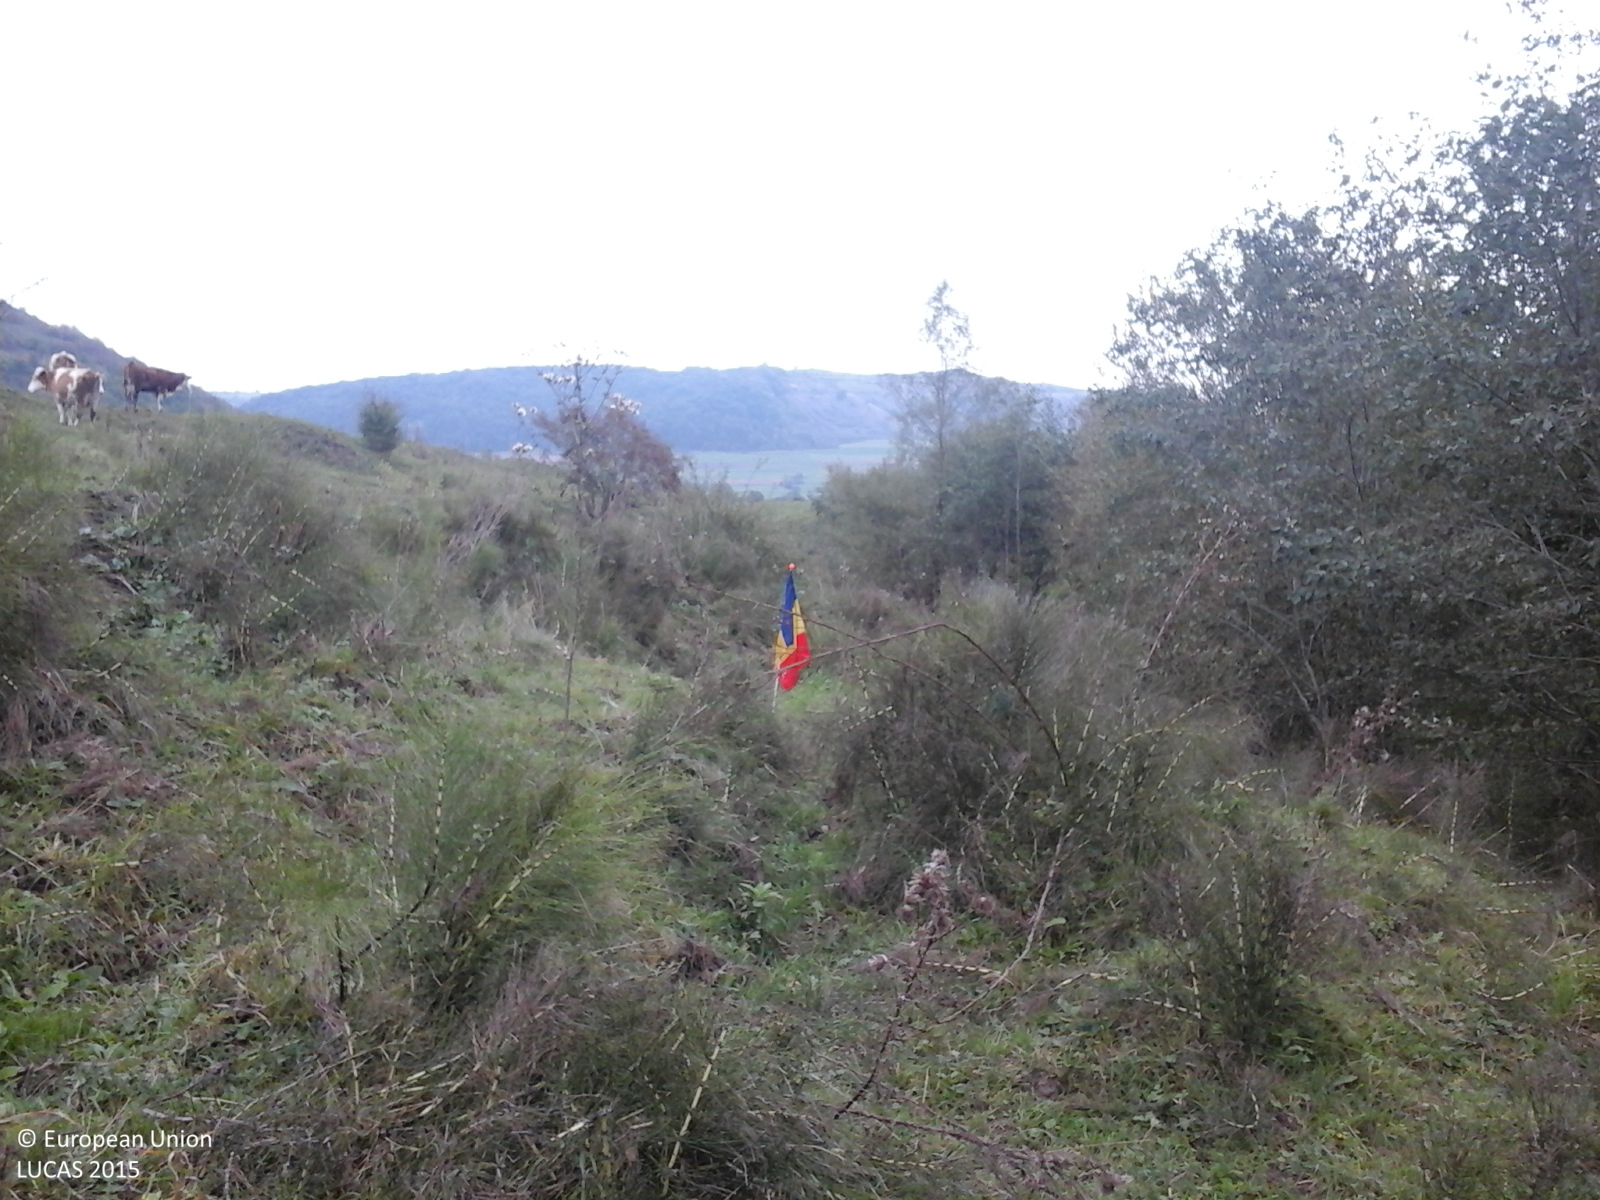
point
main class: Grassland
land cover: Grassland with sparse tree/shrub cover
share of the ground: > 75 %
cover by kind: herbaceous plants 85 %, shrubs 10 %, broadleaved forest trees 5 %
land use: Agriculture (excluding fallow land and kitchen gardens)
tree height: < 5 m
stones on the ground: 10 - 25 %
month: October
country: RO
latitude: 46.3477
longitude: 25.0005
